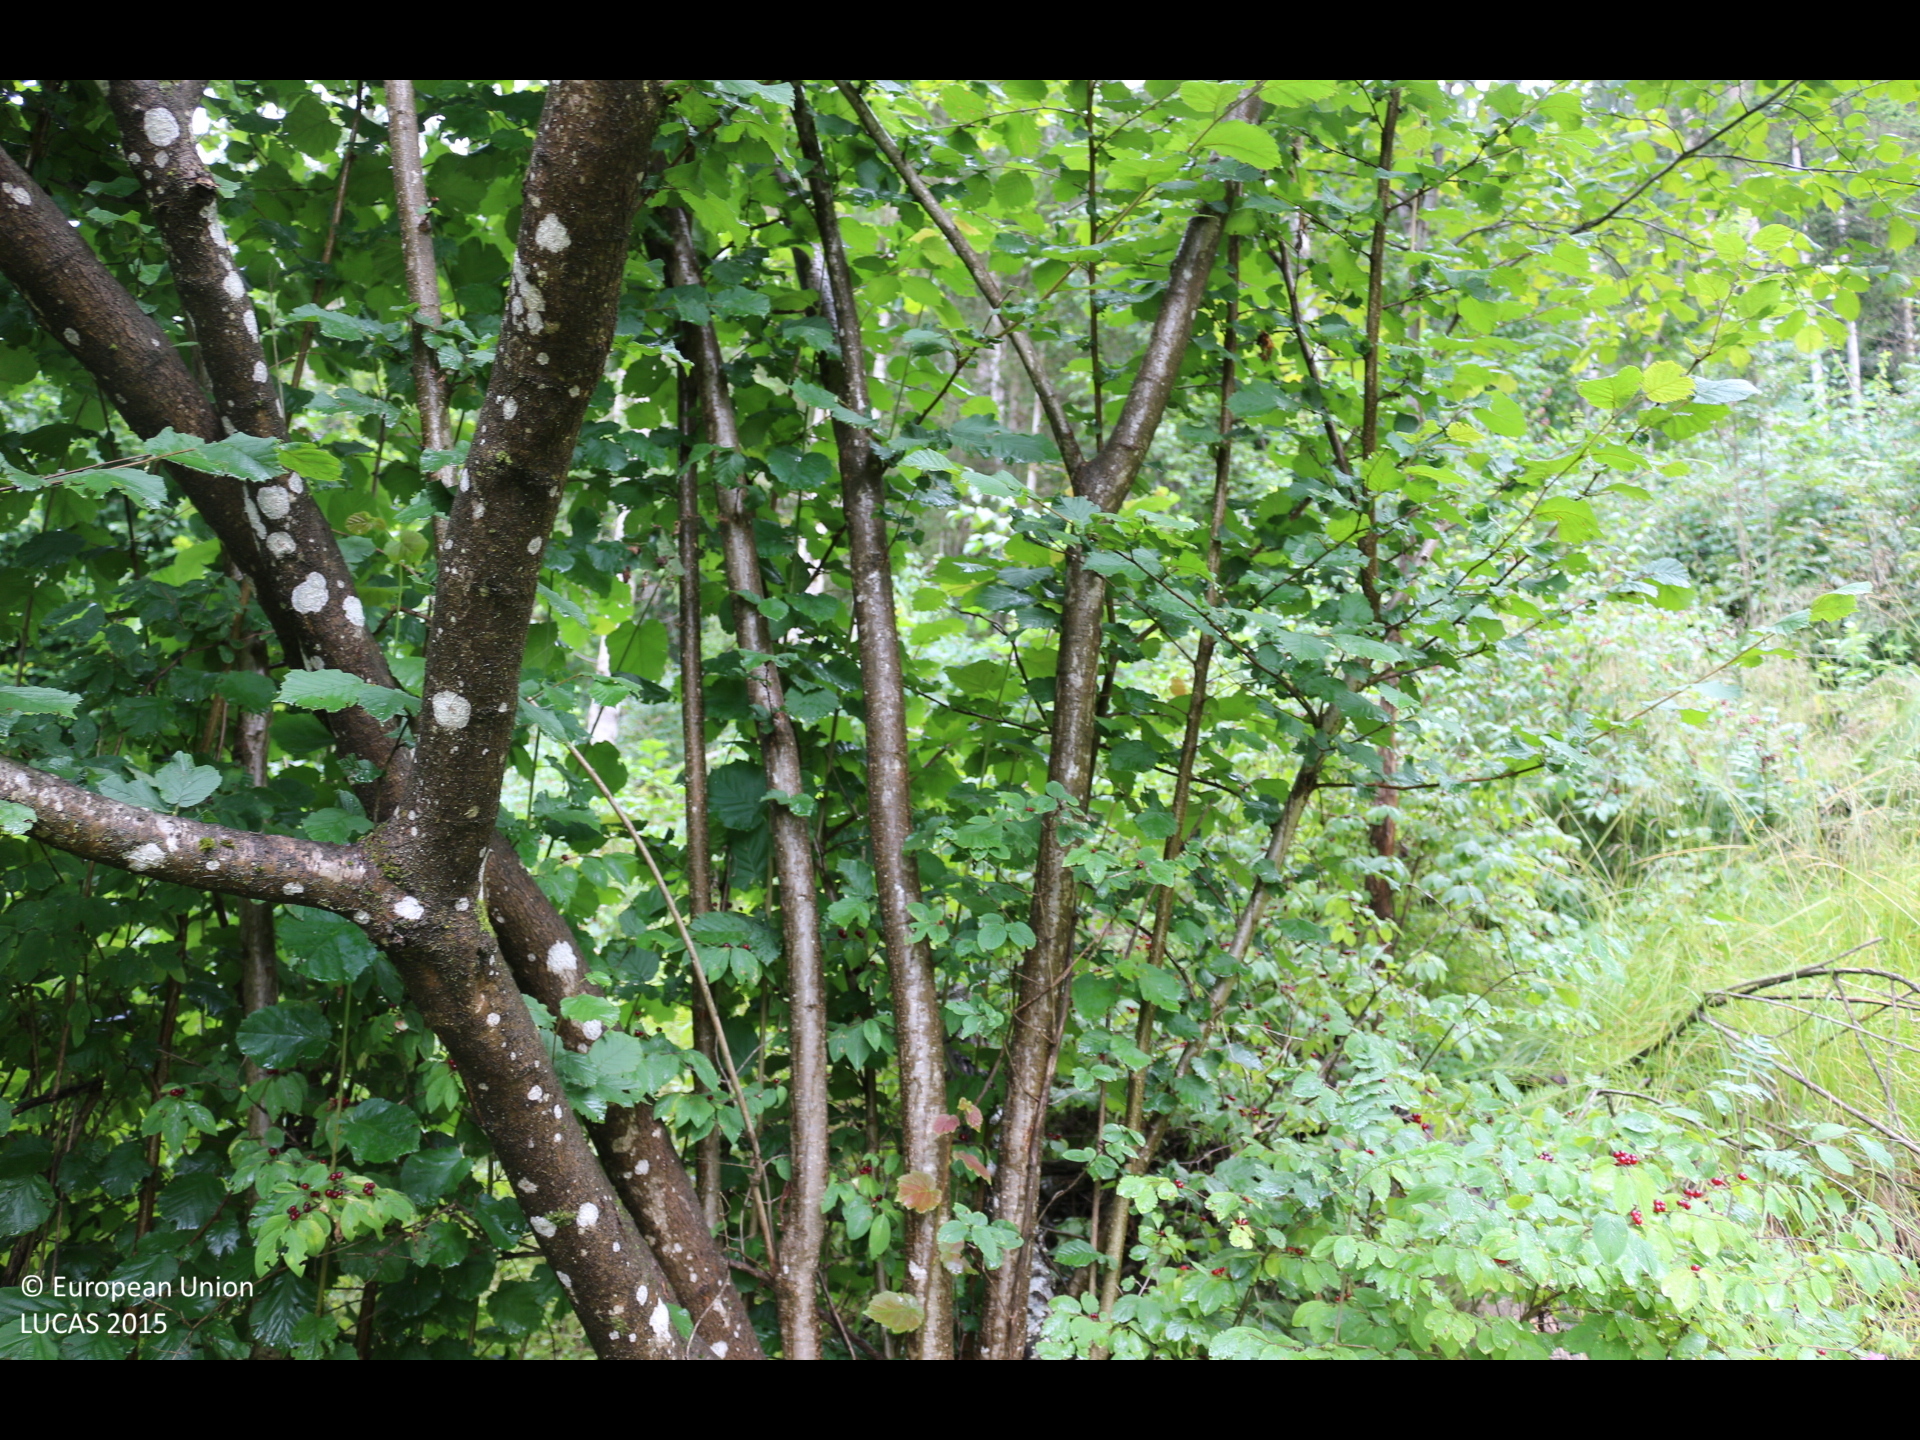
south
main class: Woodland
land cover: Spruce dominated mixed woodland
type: mountainous beech forest
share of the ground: > 75 %
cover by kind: coniferous forest trees 65 %, broadleaved forest trees 25 %, shrubs 5 %, herbaceous plants 5 %
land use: Forestry
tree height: > 5 m
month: July
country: AT
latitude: 46.9682
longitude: 14.2959
